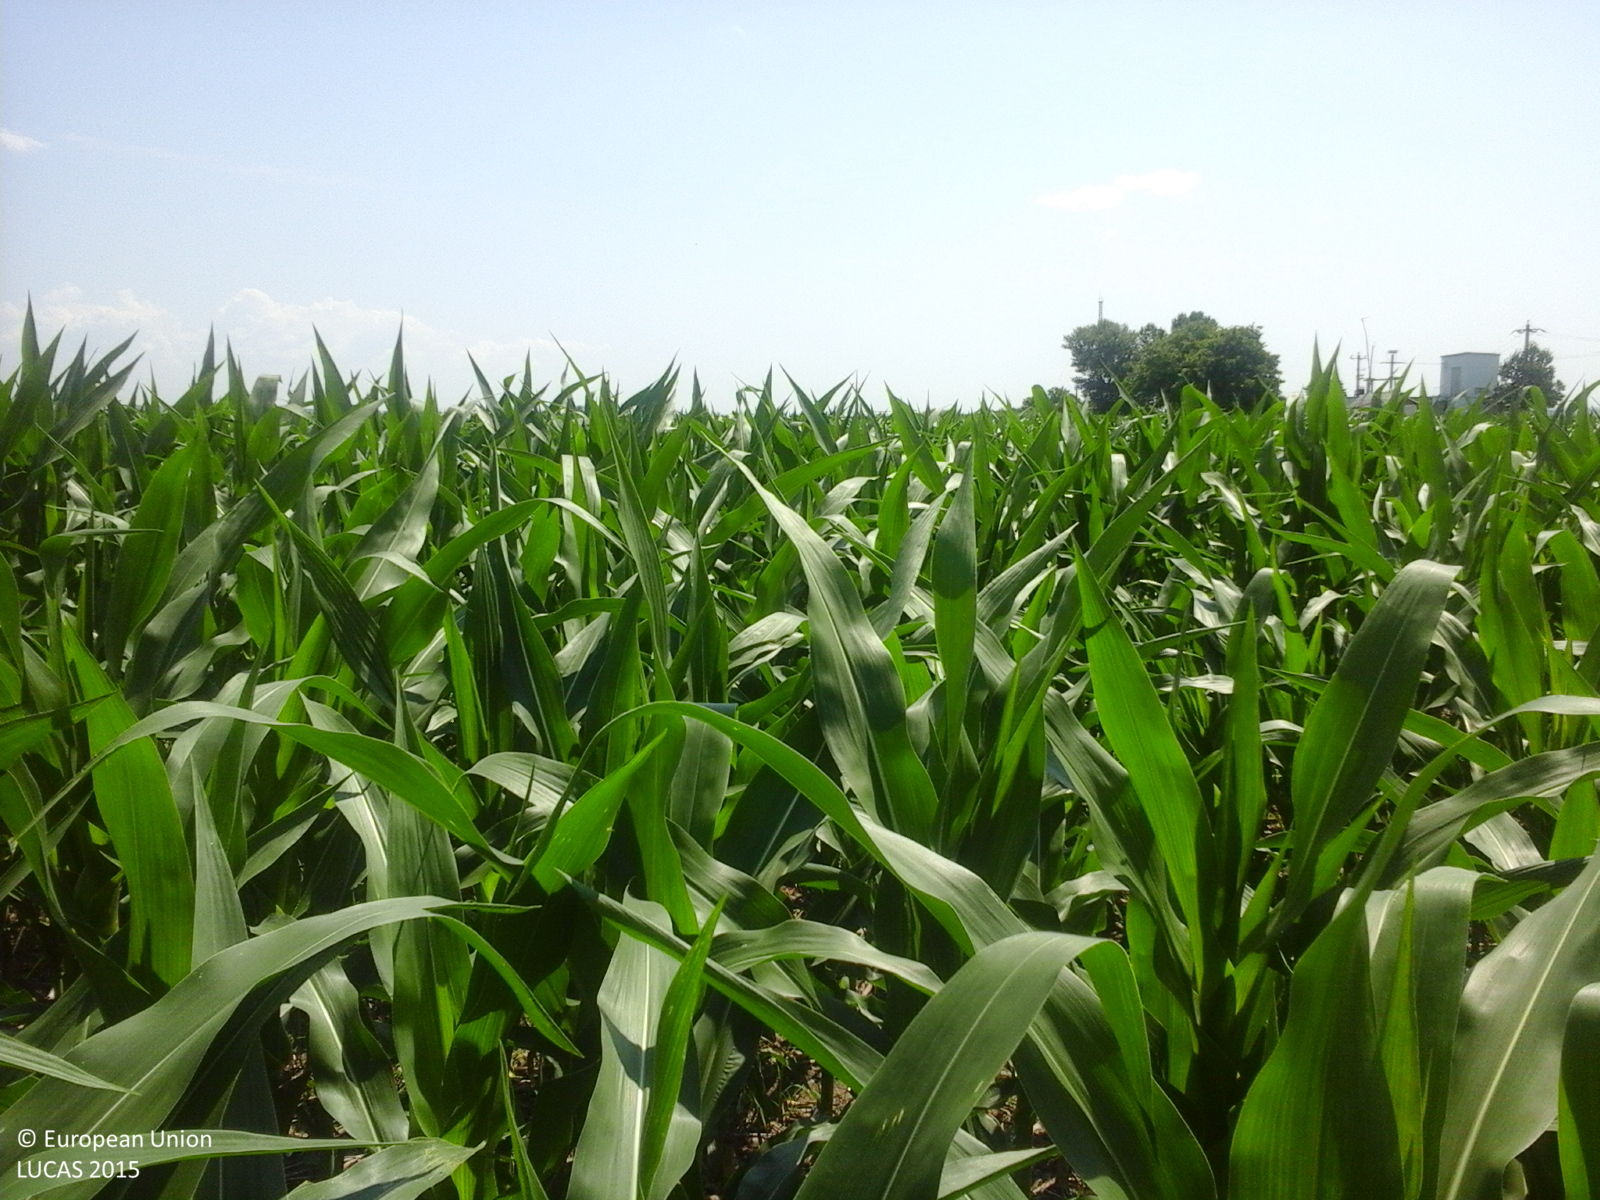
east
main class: Cropland
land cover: Maize
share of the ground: > 75 %
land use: Agriculture (excluding fallow land and kitchen gardens)
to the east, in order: Maize
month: June
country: RO
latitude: 44.0951
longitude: 26.4352
